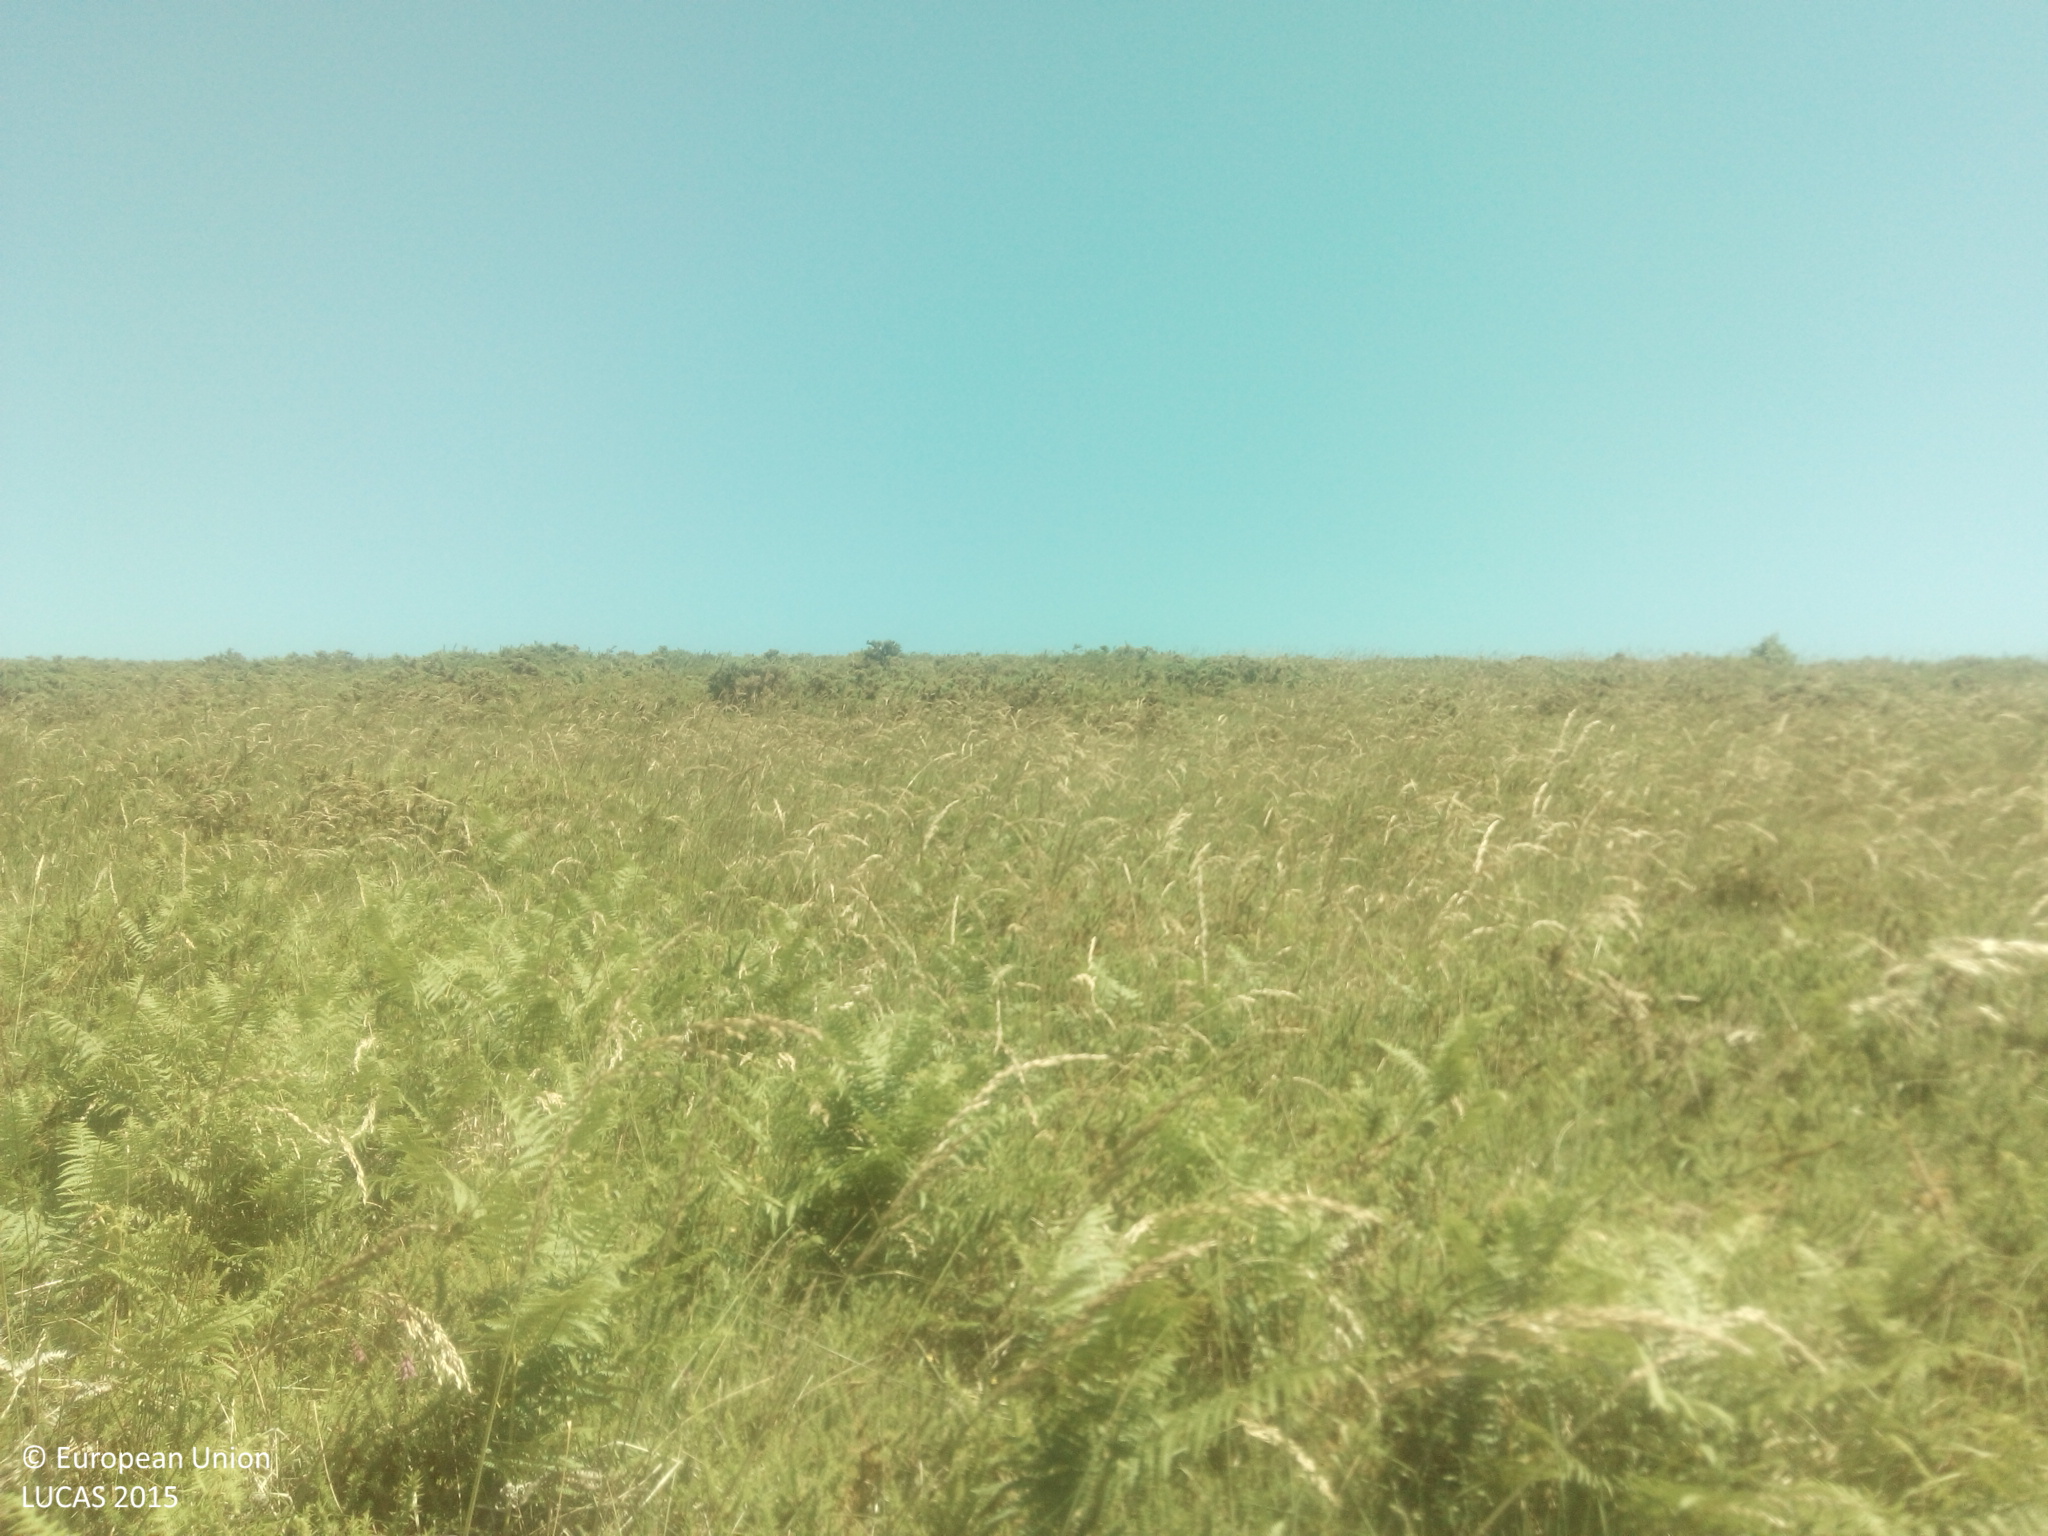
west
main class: Shrubland
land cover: Shrubland without tree cover
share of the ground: > 75 %
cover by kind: shrubs 100 %
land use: Semi-natural and natural areas not in use
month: June
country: ES
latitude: 42.4575
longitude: -8.3455
